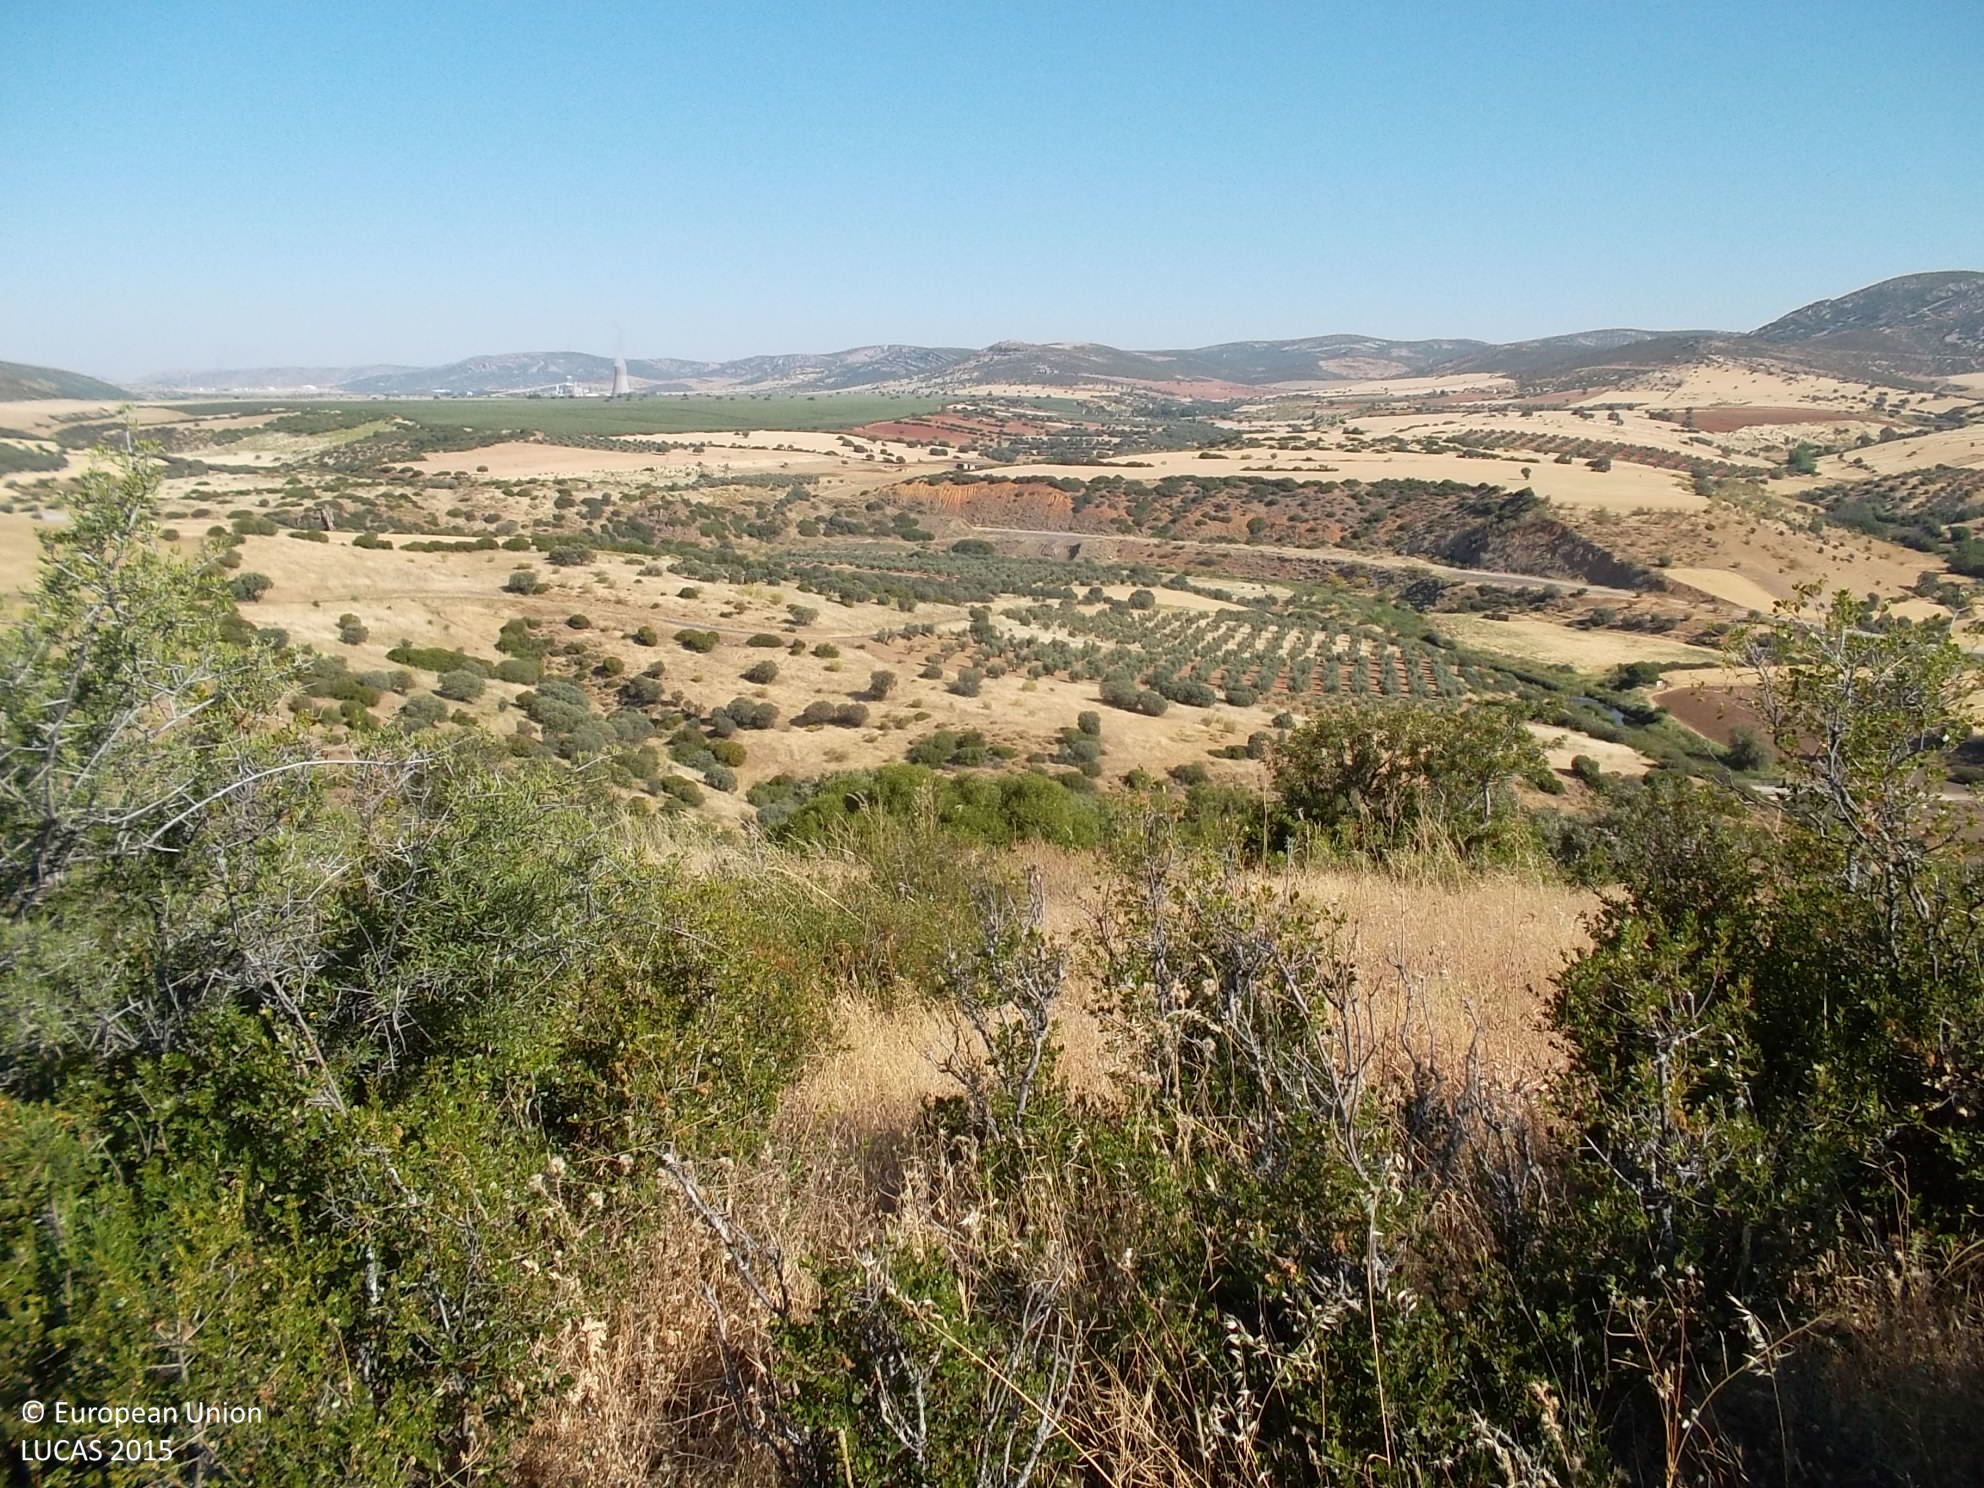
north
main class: Woodland
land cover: Broadleaved woodland
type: broadleaved evergreen forest
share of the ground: 25 - 50 %
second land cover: Spontaneously vegetated surfaces
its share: 50 - 75 %
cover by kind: herbaceous plants 50 %, shrubs 30 %, broadleaved forest trees 20 %
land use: Forestry
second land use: Agriculture (excluding fallow land and kitchen gardens)
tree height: < 5 m
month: May
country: ES
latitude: 38.6092
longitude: -3.9217
